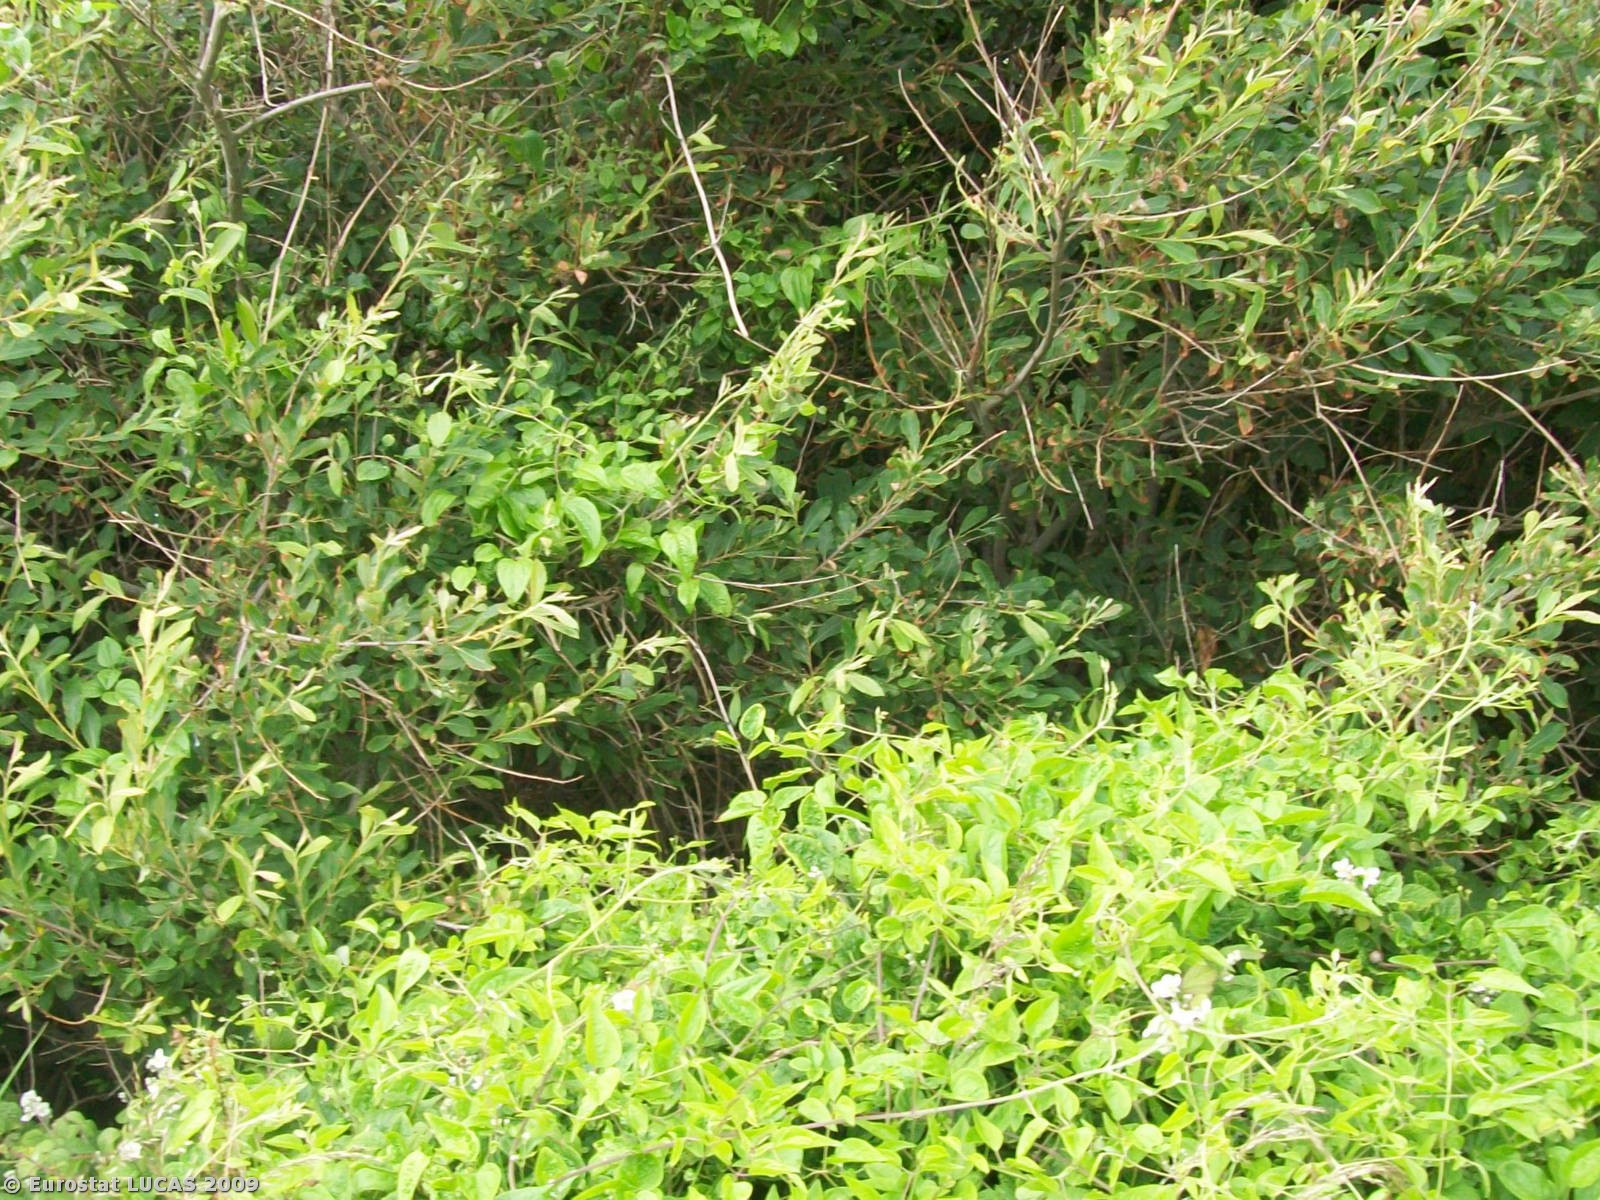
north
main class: Cropland
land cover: Common wheat
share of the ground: > 75 %
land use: Agriculture (excluding fallow land and kitchen gardens)
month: June
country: GB
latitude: 50.7969
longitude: -0.5806
